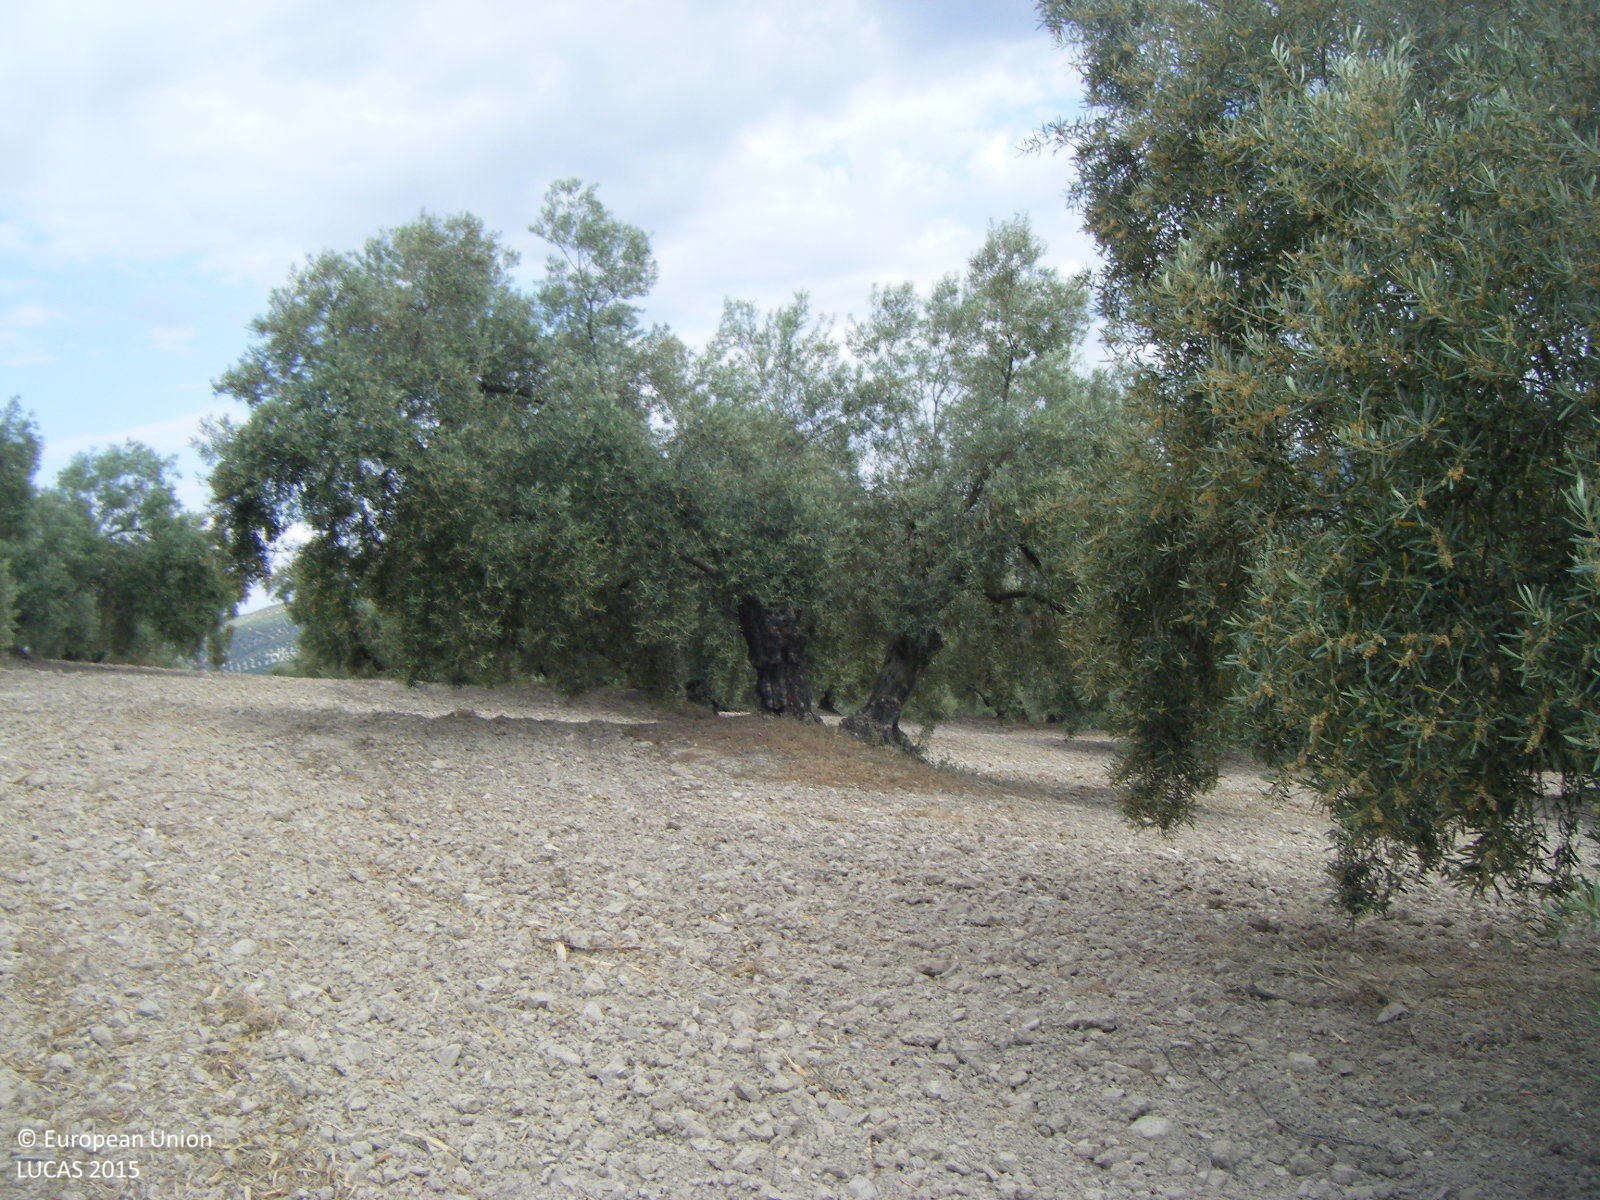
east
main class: Cropland
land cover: Olive groves
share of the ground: 10 - 25 %
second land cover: Other bare soil
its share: > 75 %
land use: Agriculture (excluding fallow land and kitchen gardens)
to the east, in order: Olive groves; Other bare soil
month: May
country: ES
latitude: 37.2137
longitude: -4.4109
